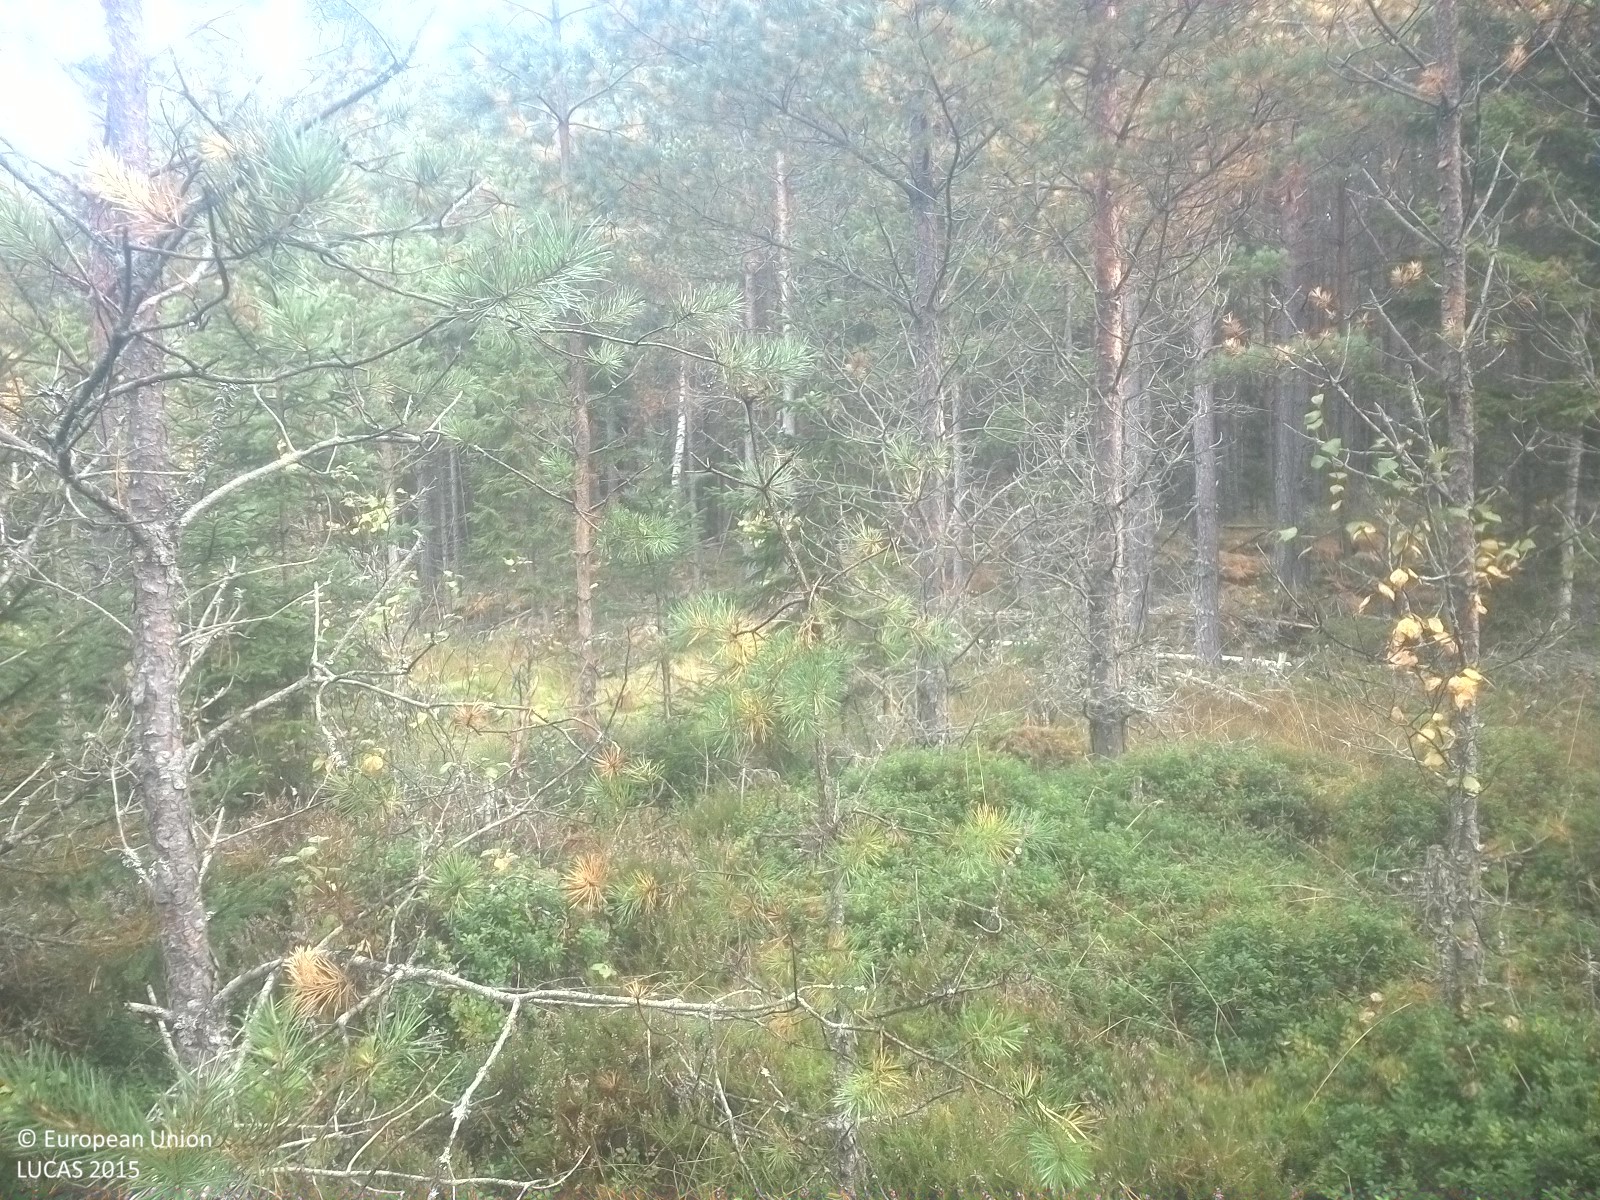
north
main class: Woodland
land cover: Pine dominated coniferous woodland
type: boreal forest
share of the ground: 25 - 50 %
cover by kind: coniferous forest trees 35 %, herbaceous plants 35 %, lichens and mosses 15 %, shrubs 10 %, broadleaved forest trees 5 %
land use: Forestry
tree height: < 5 m
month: September
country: SE
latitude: 58.8593
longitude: 15.6277
